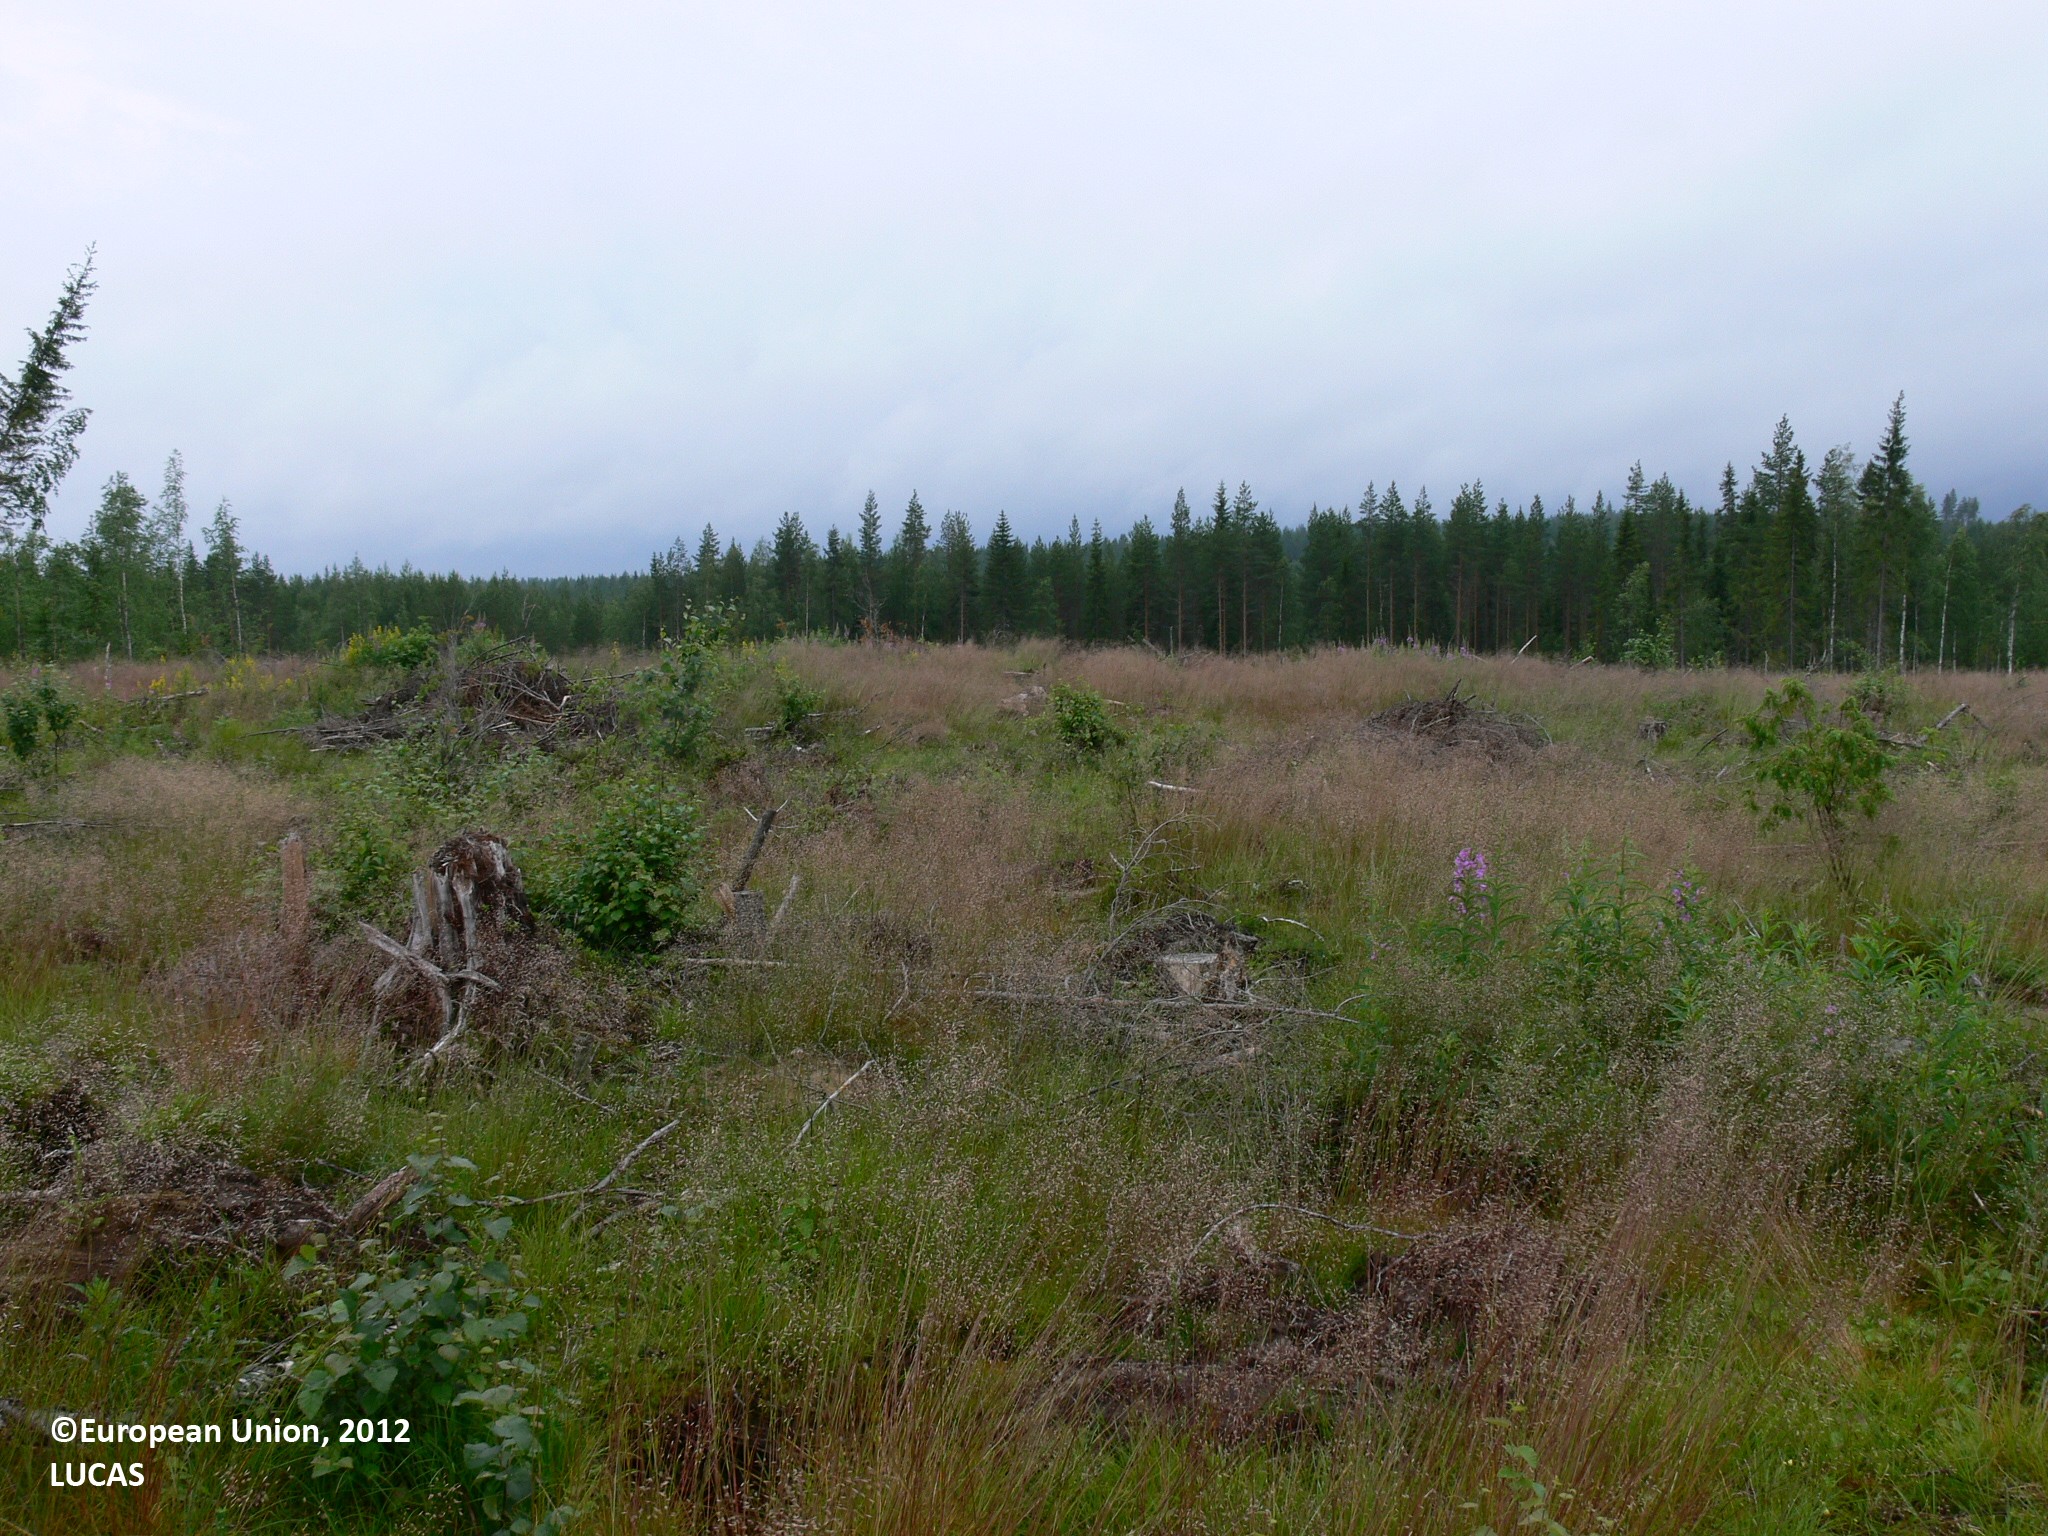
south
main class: Woodland
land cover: Pine dominated coniferous woodland
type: boreal forest
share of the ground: < 10 %
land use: Forestry
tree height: < 5 m
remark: Clear cut
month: July
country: FI
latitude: 63.1512
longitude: 30.8721
